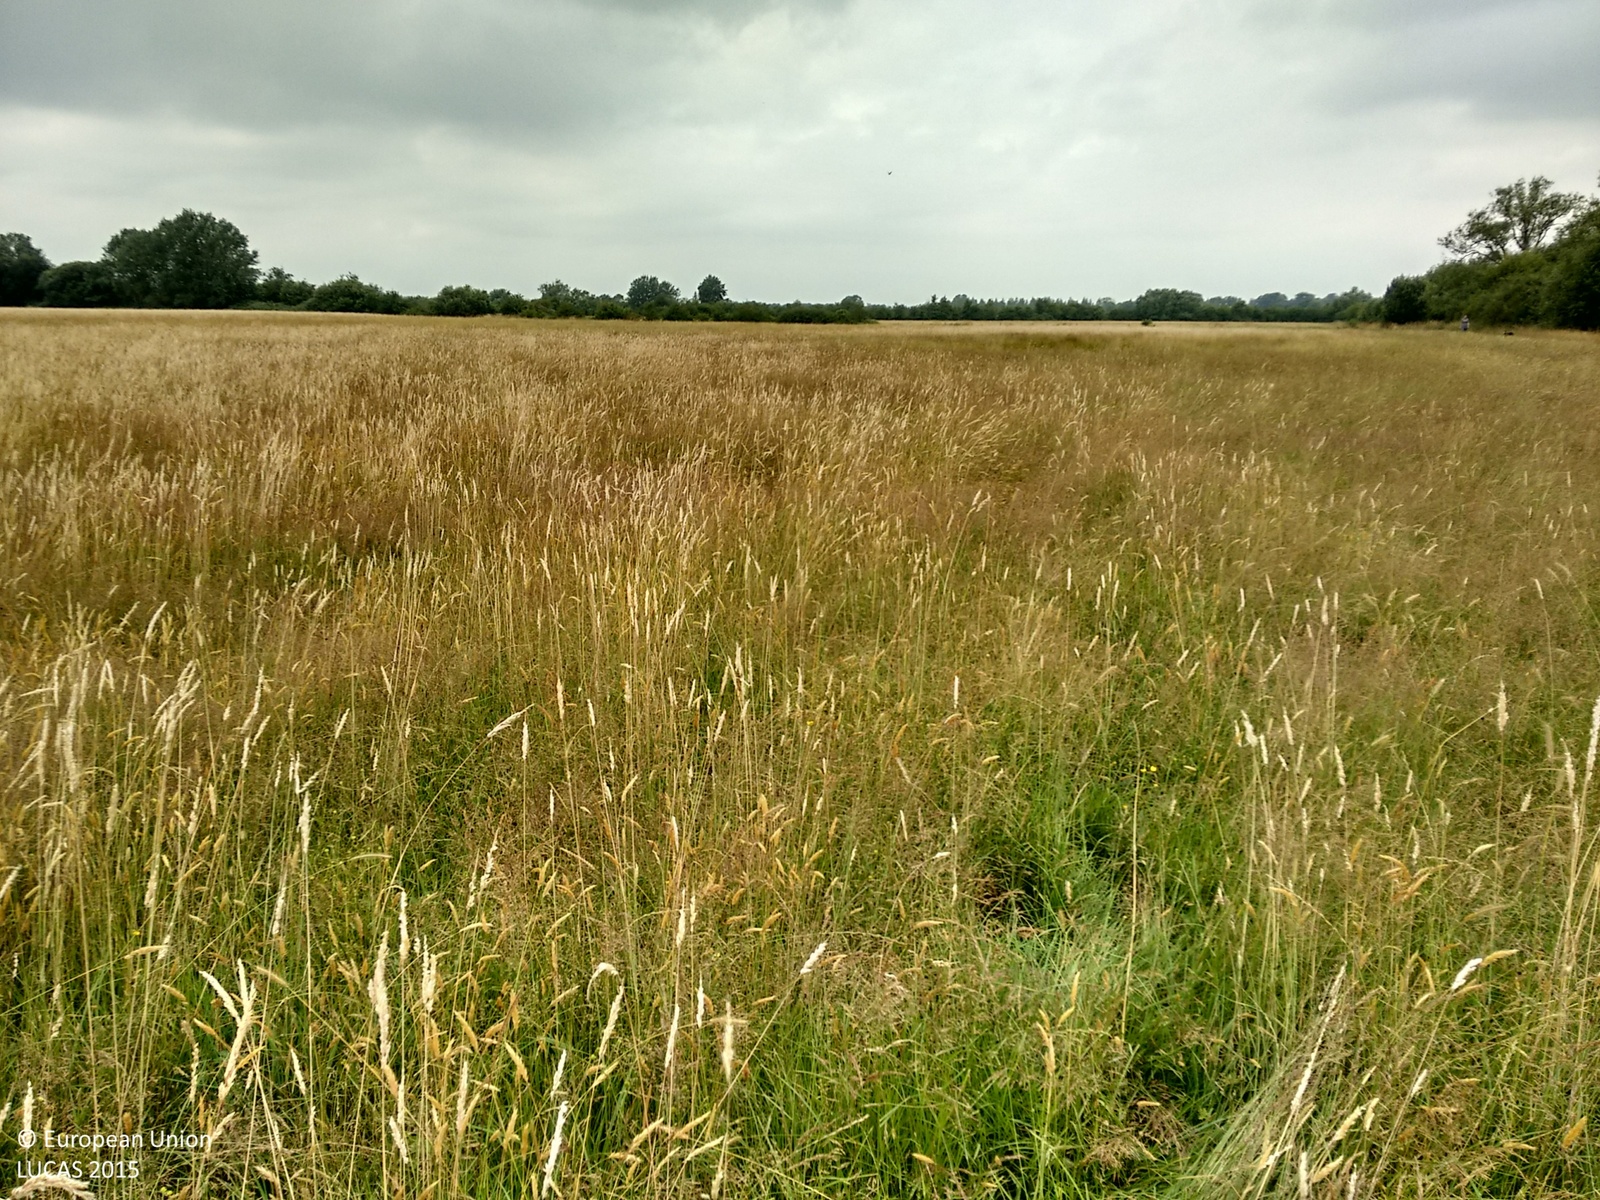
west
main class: Grassland
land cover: Grassland without tree/shrub cover
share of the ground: > 75 %
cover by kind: herbaceous plants 100 %
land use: Agriculture (excluding fallow land and kitchen gardens)
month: July
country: GB
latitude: 51.8297
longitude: -1.1764
